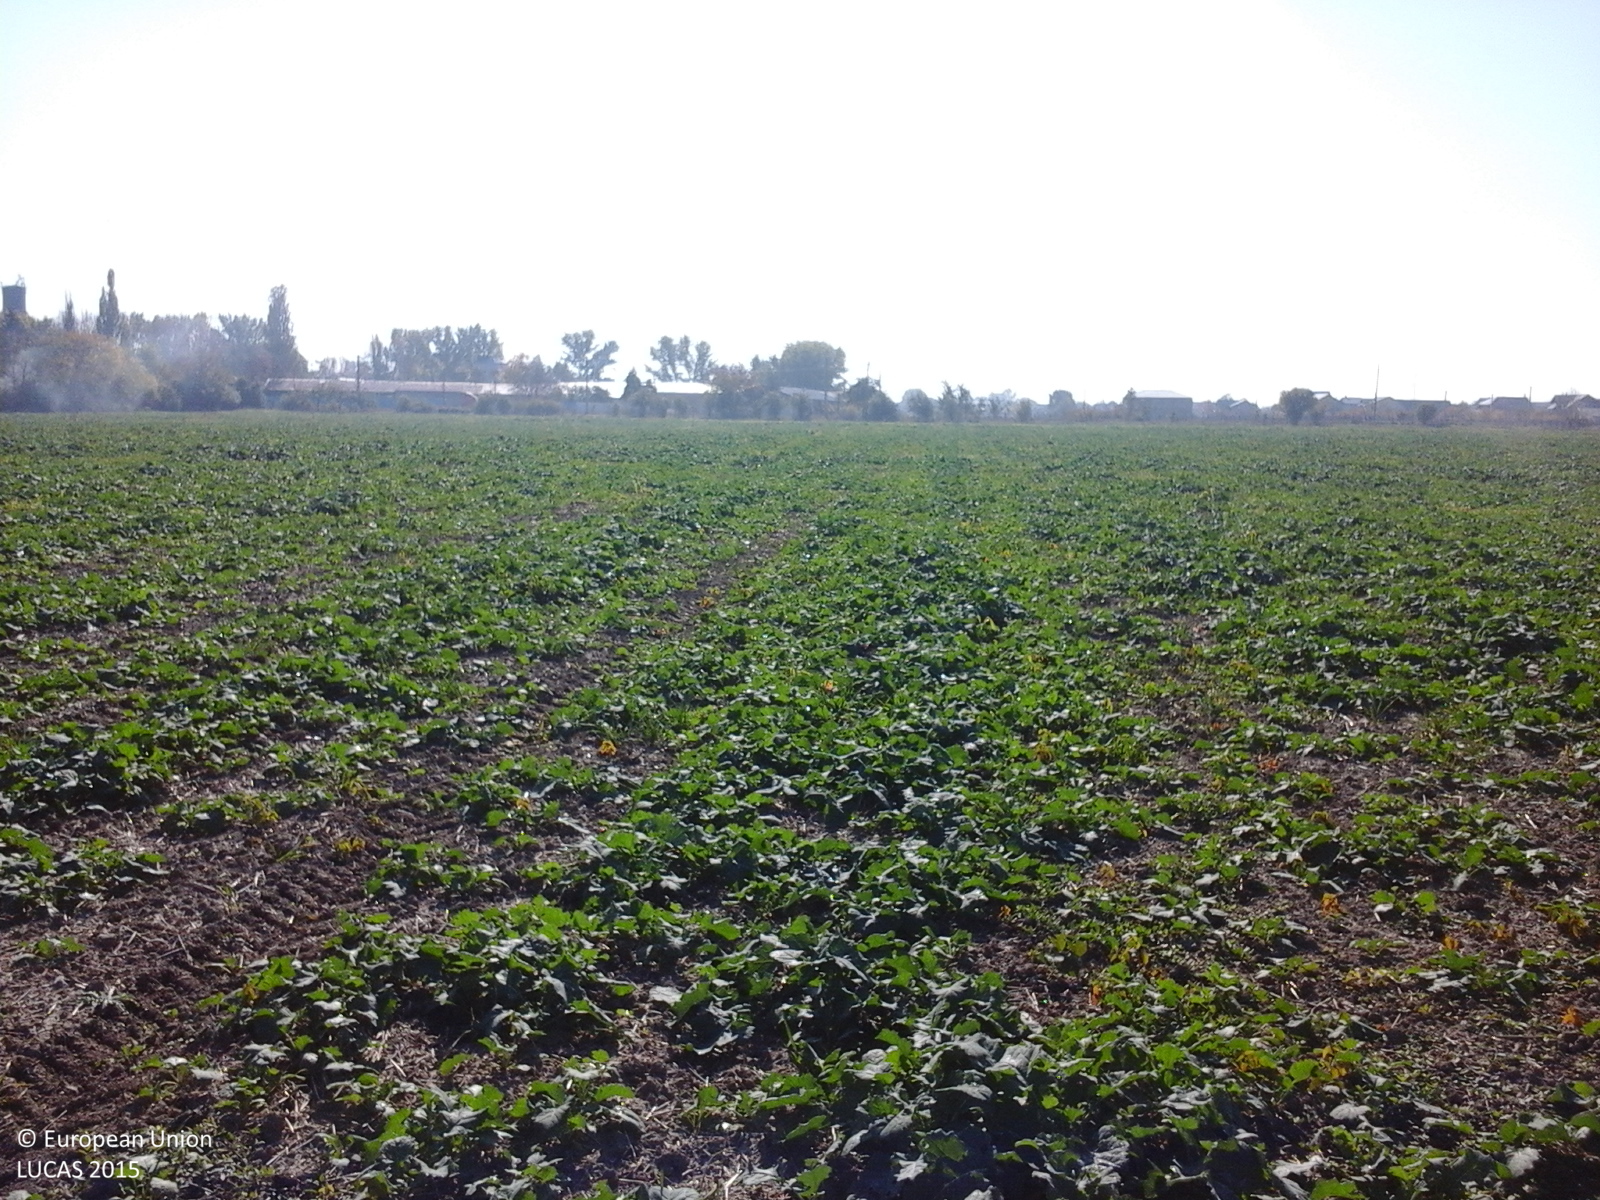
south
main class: Cropland
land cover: Rape and turnip rape
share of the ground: > 75 %
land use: Agriculture (excluding fallow land and kitchen gardens)
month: October
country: RO
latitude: 45.7047
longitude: 27.1643
